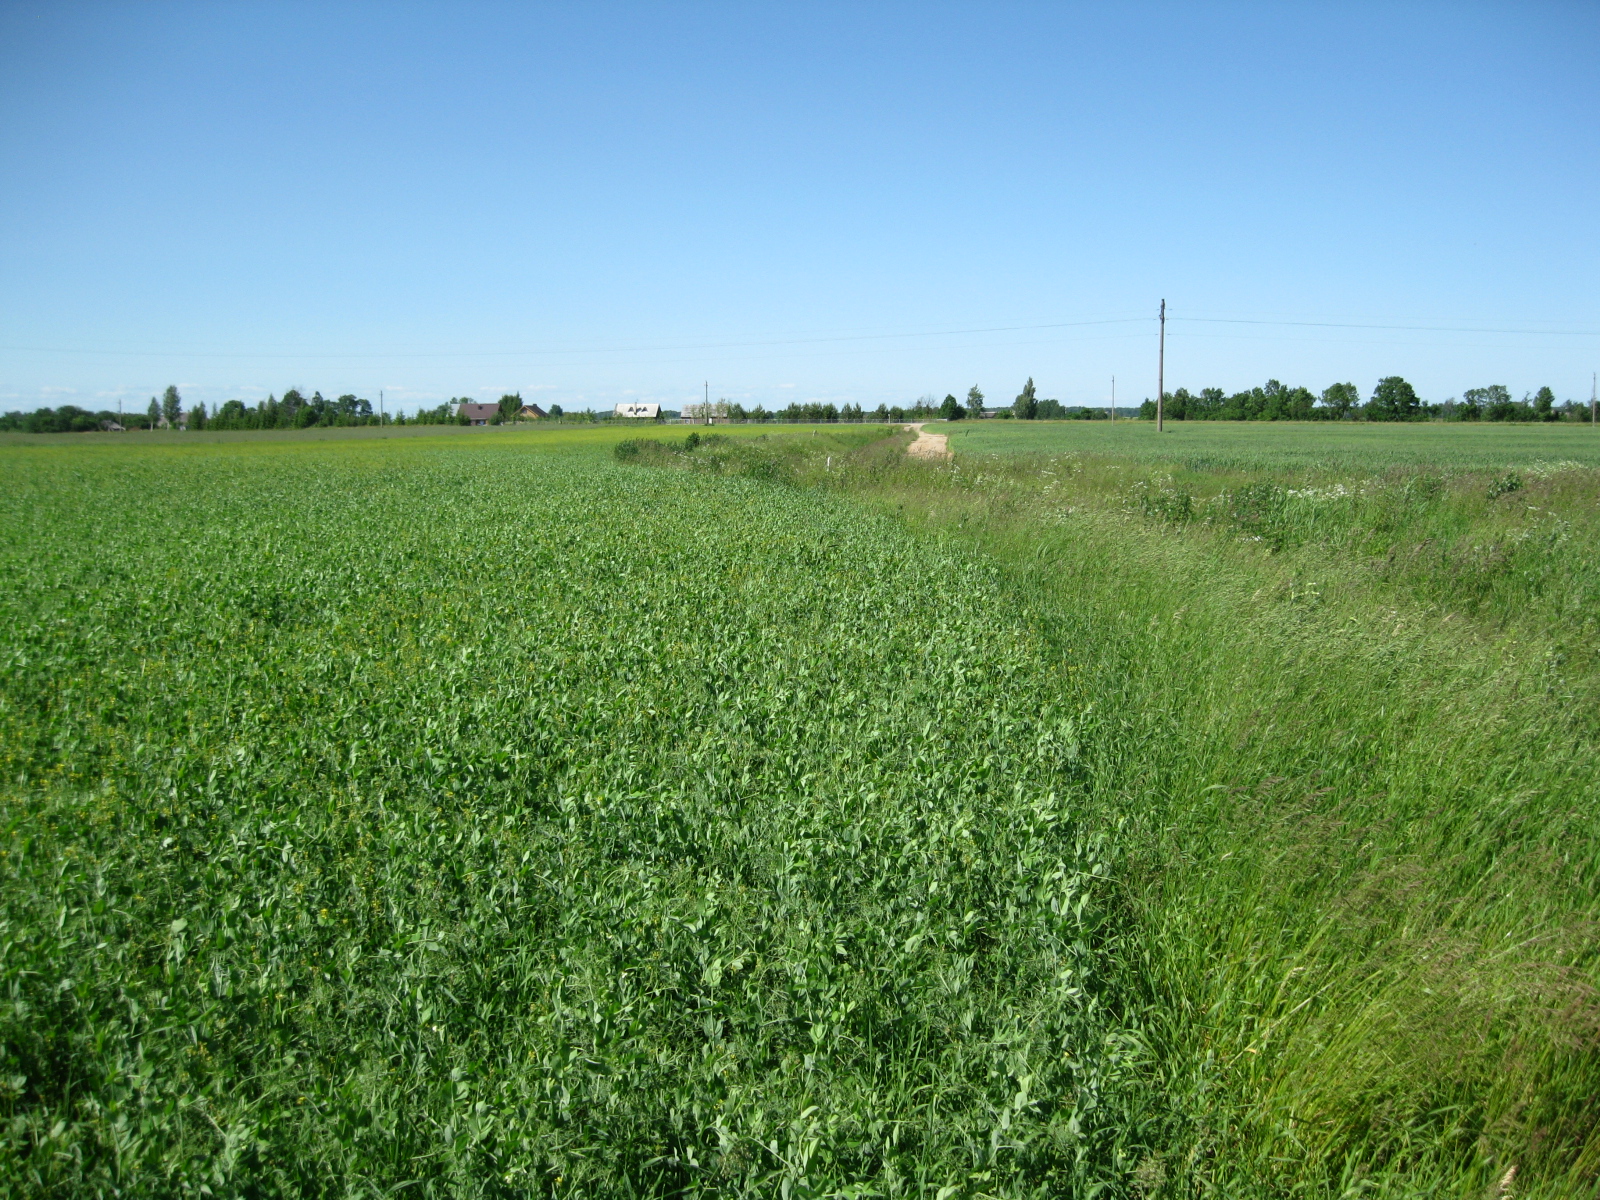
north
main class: Cropland
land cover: Dry pulses
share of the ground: > 75 %
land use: Agriculture (excluding fallow land and kitchen gardens)
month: June
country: LT
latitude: 55.2801
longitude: 23.7336
